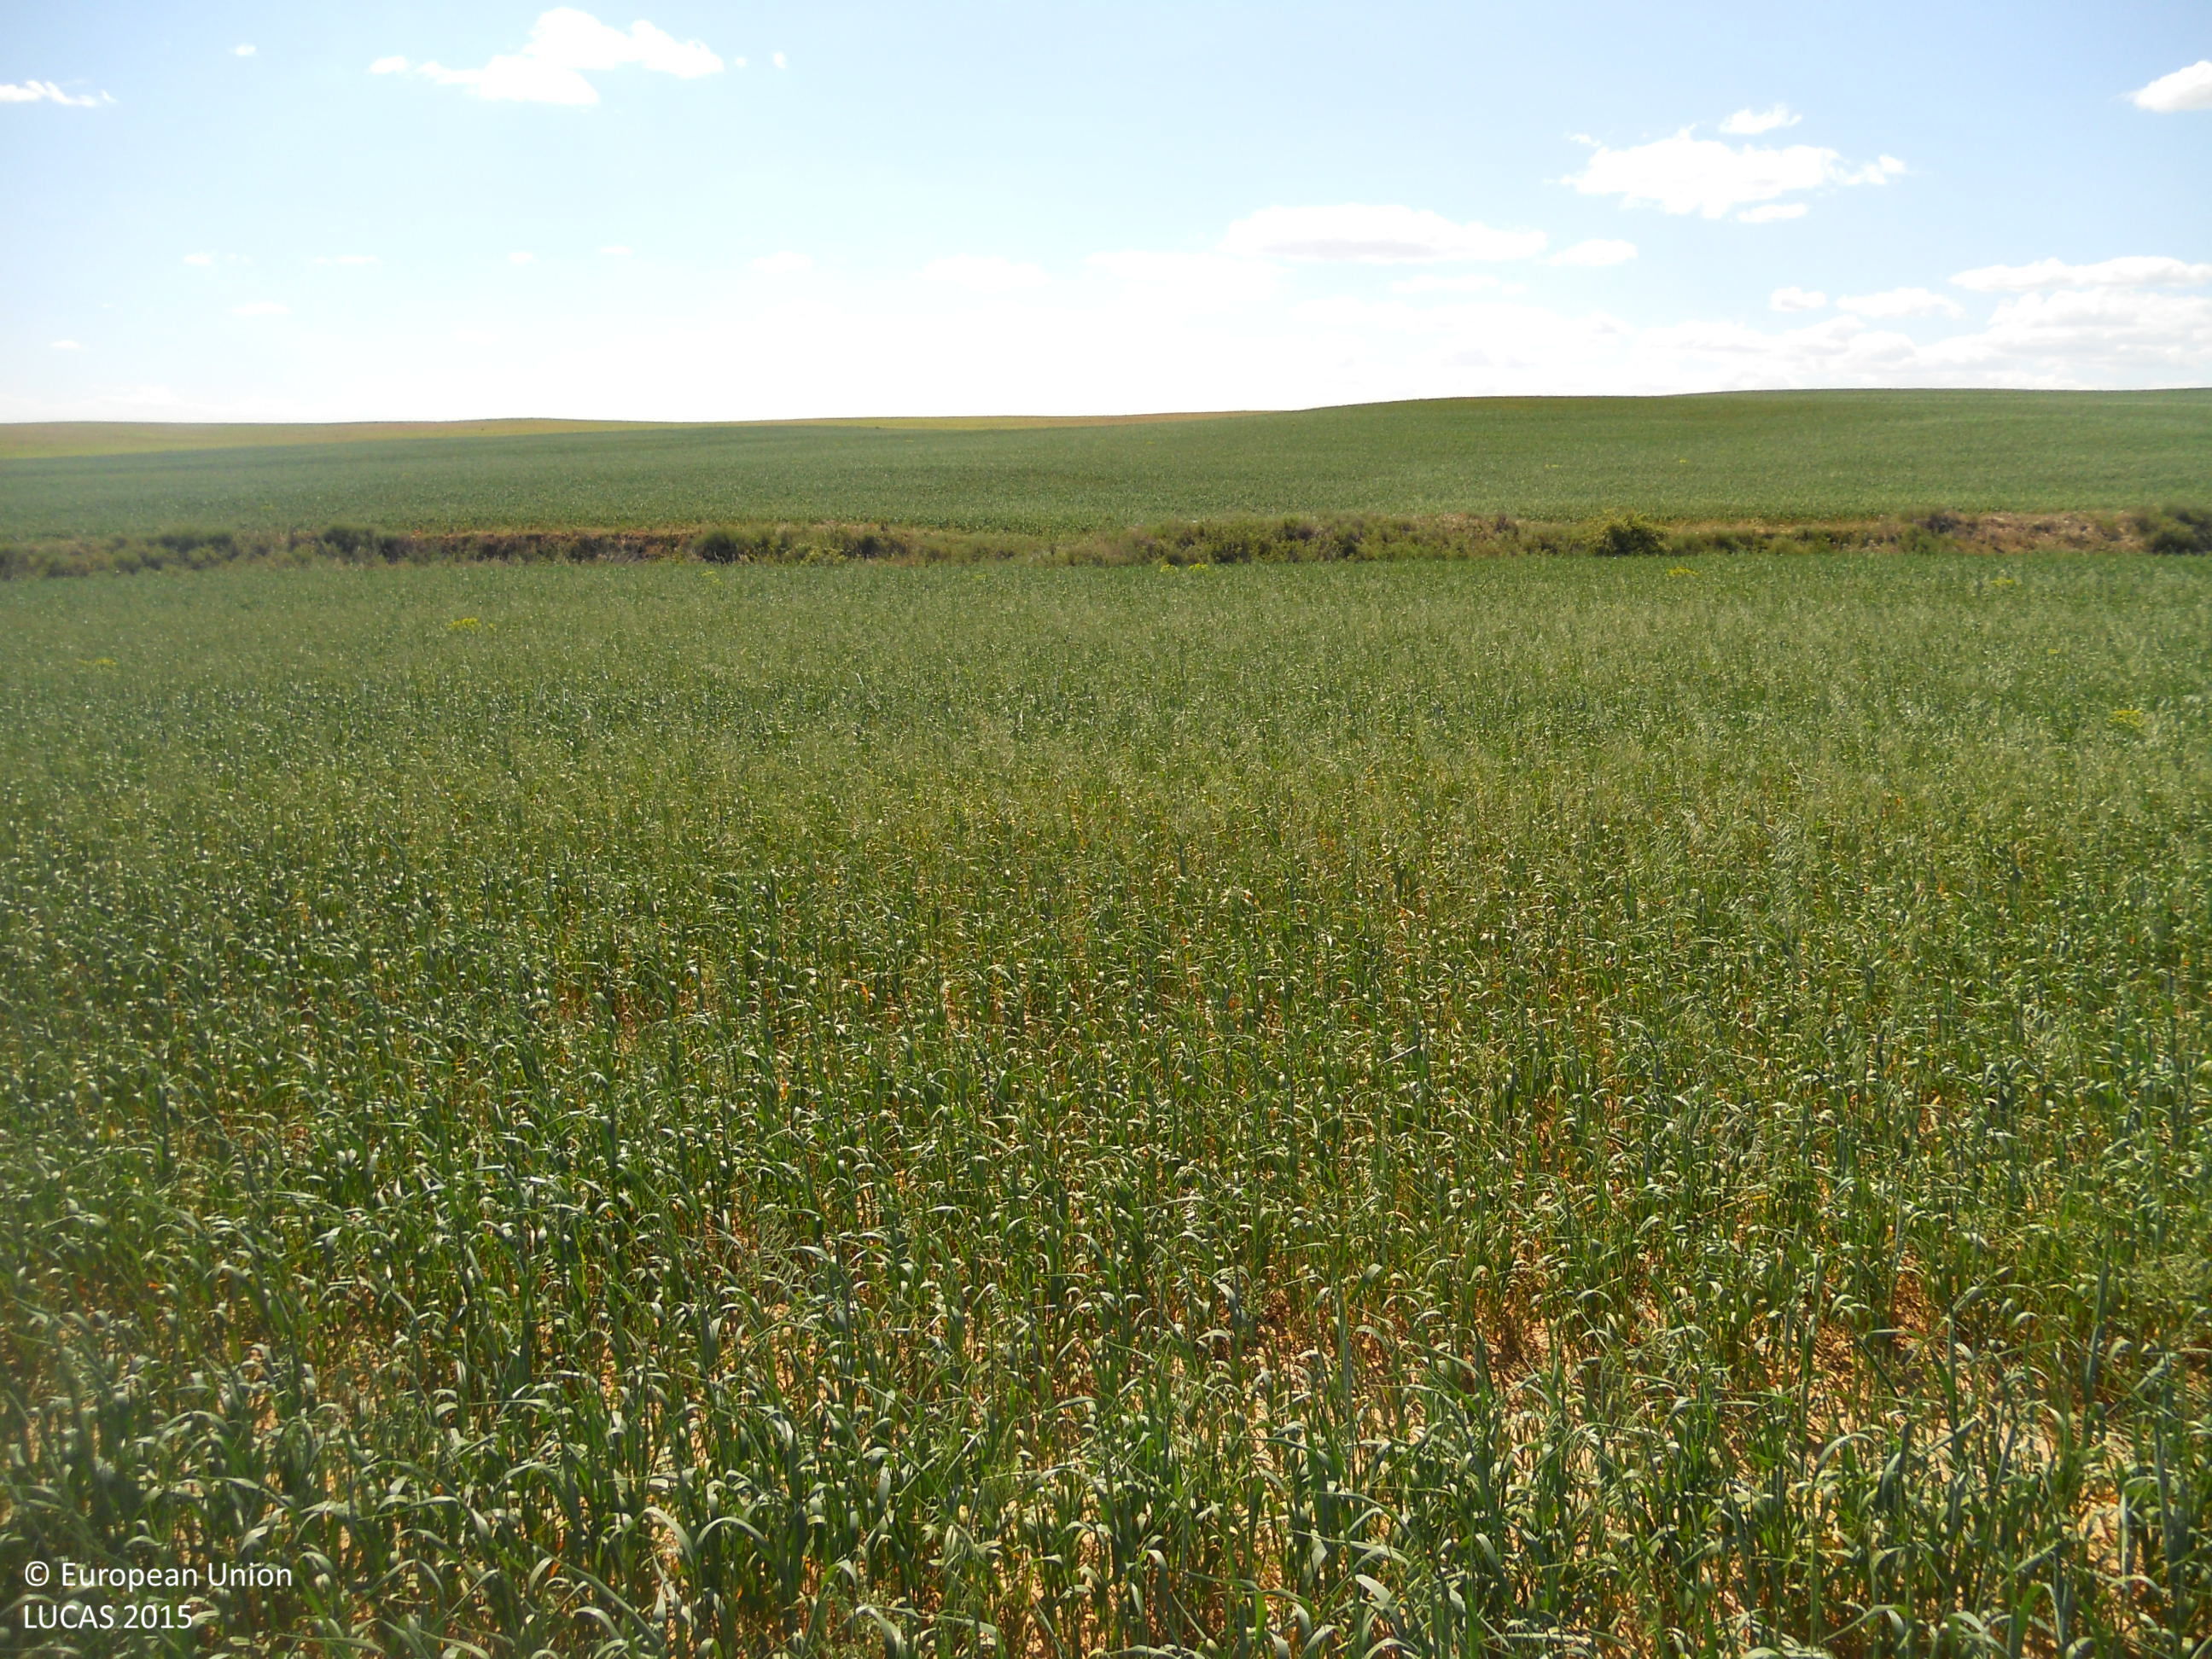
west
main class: Cropland
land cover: Oats
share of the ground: > 75 %
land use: Agriculture (excluding fallow land and kitchen gardens)
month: May
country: ES
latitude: 42.2732
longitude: -4.8099
